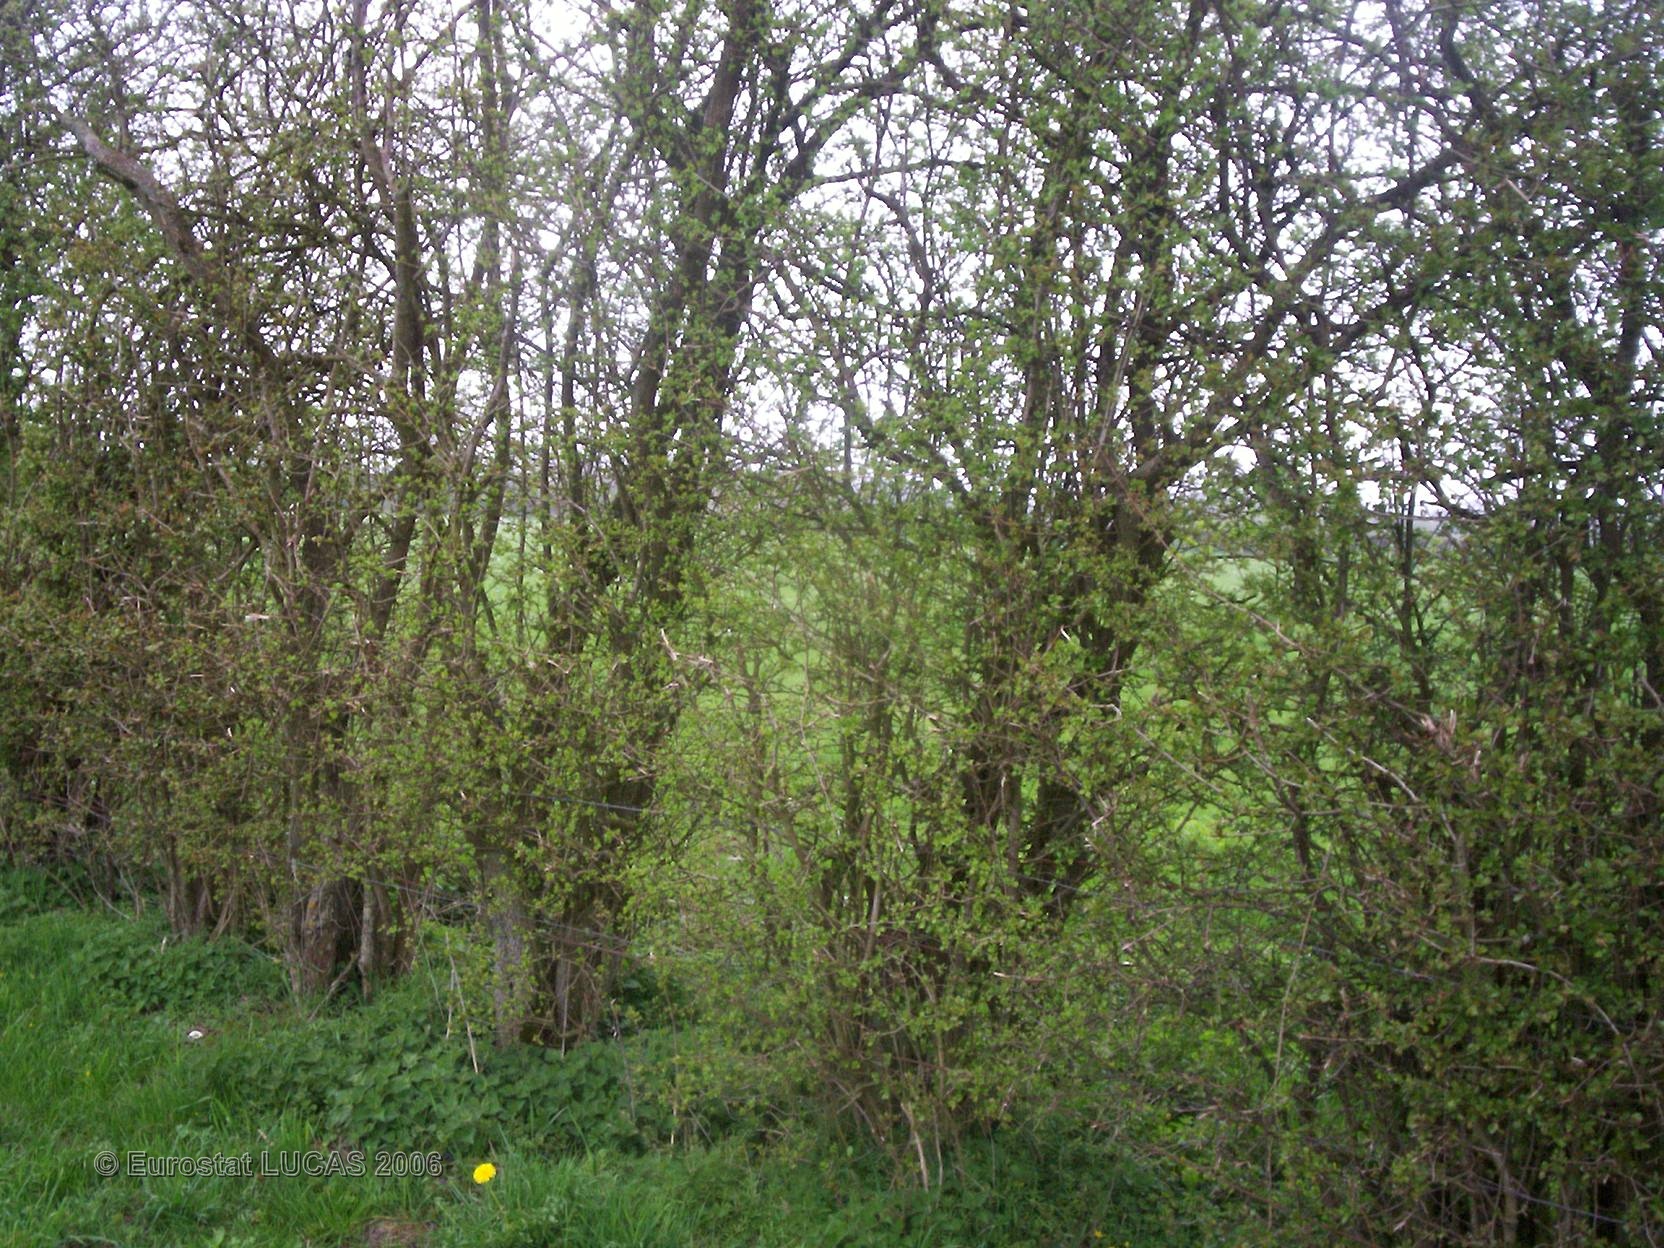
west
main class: Grassland
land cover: Grassland without tree/shrub cover
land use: Agriculture (excluding fallow land and kitchen gardens)
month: April
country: FR
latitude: 50.1594
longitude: 3.7926
